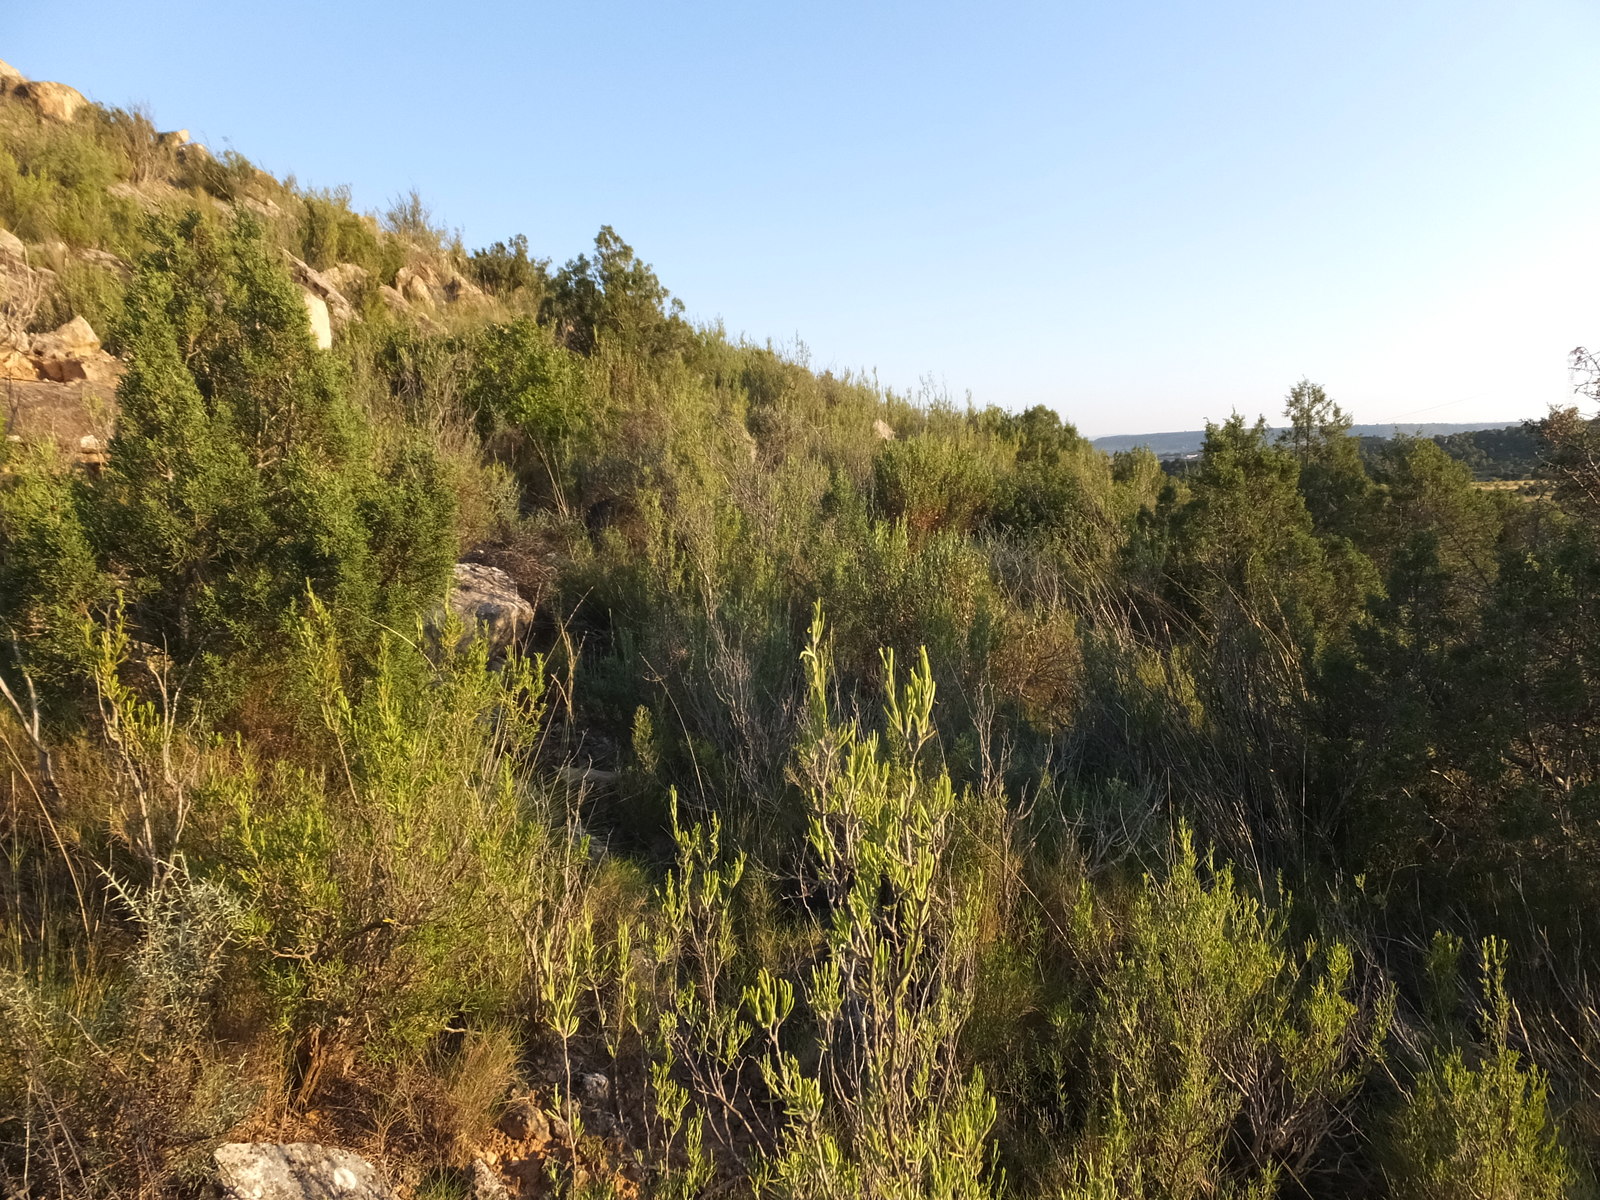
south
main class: Shrubland
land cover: Shrubland with sparse tree cover
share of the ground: > 75 %
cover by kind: shrubs 75 %, herbaceous plants 20 %, coniferous forest trees 5 %
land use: Semi-natural and natural areas not in use
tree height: < 5 m
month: June
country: ES
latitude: 41.3087
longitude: -0.2988
